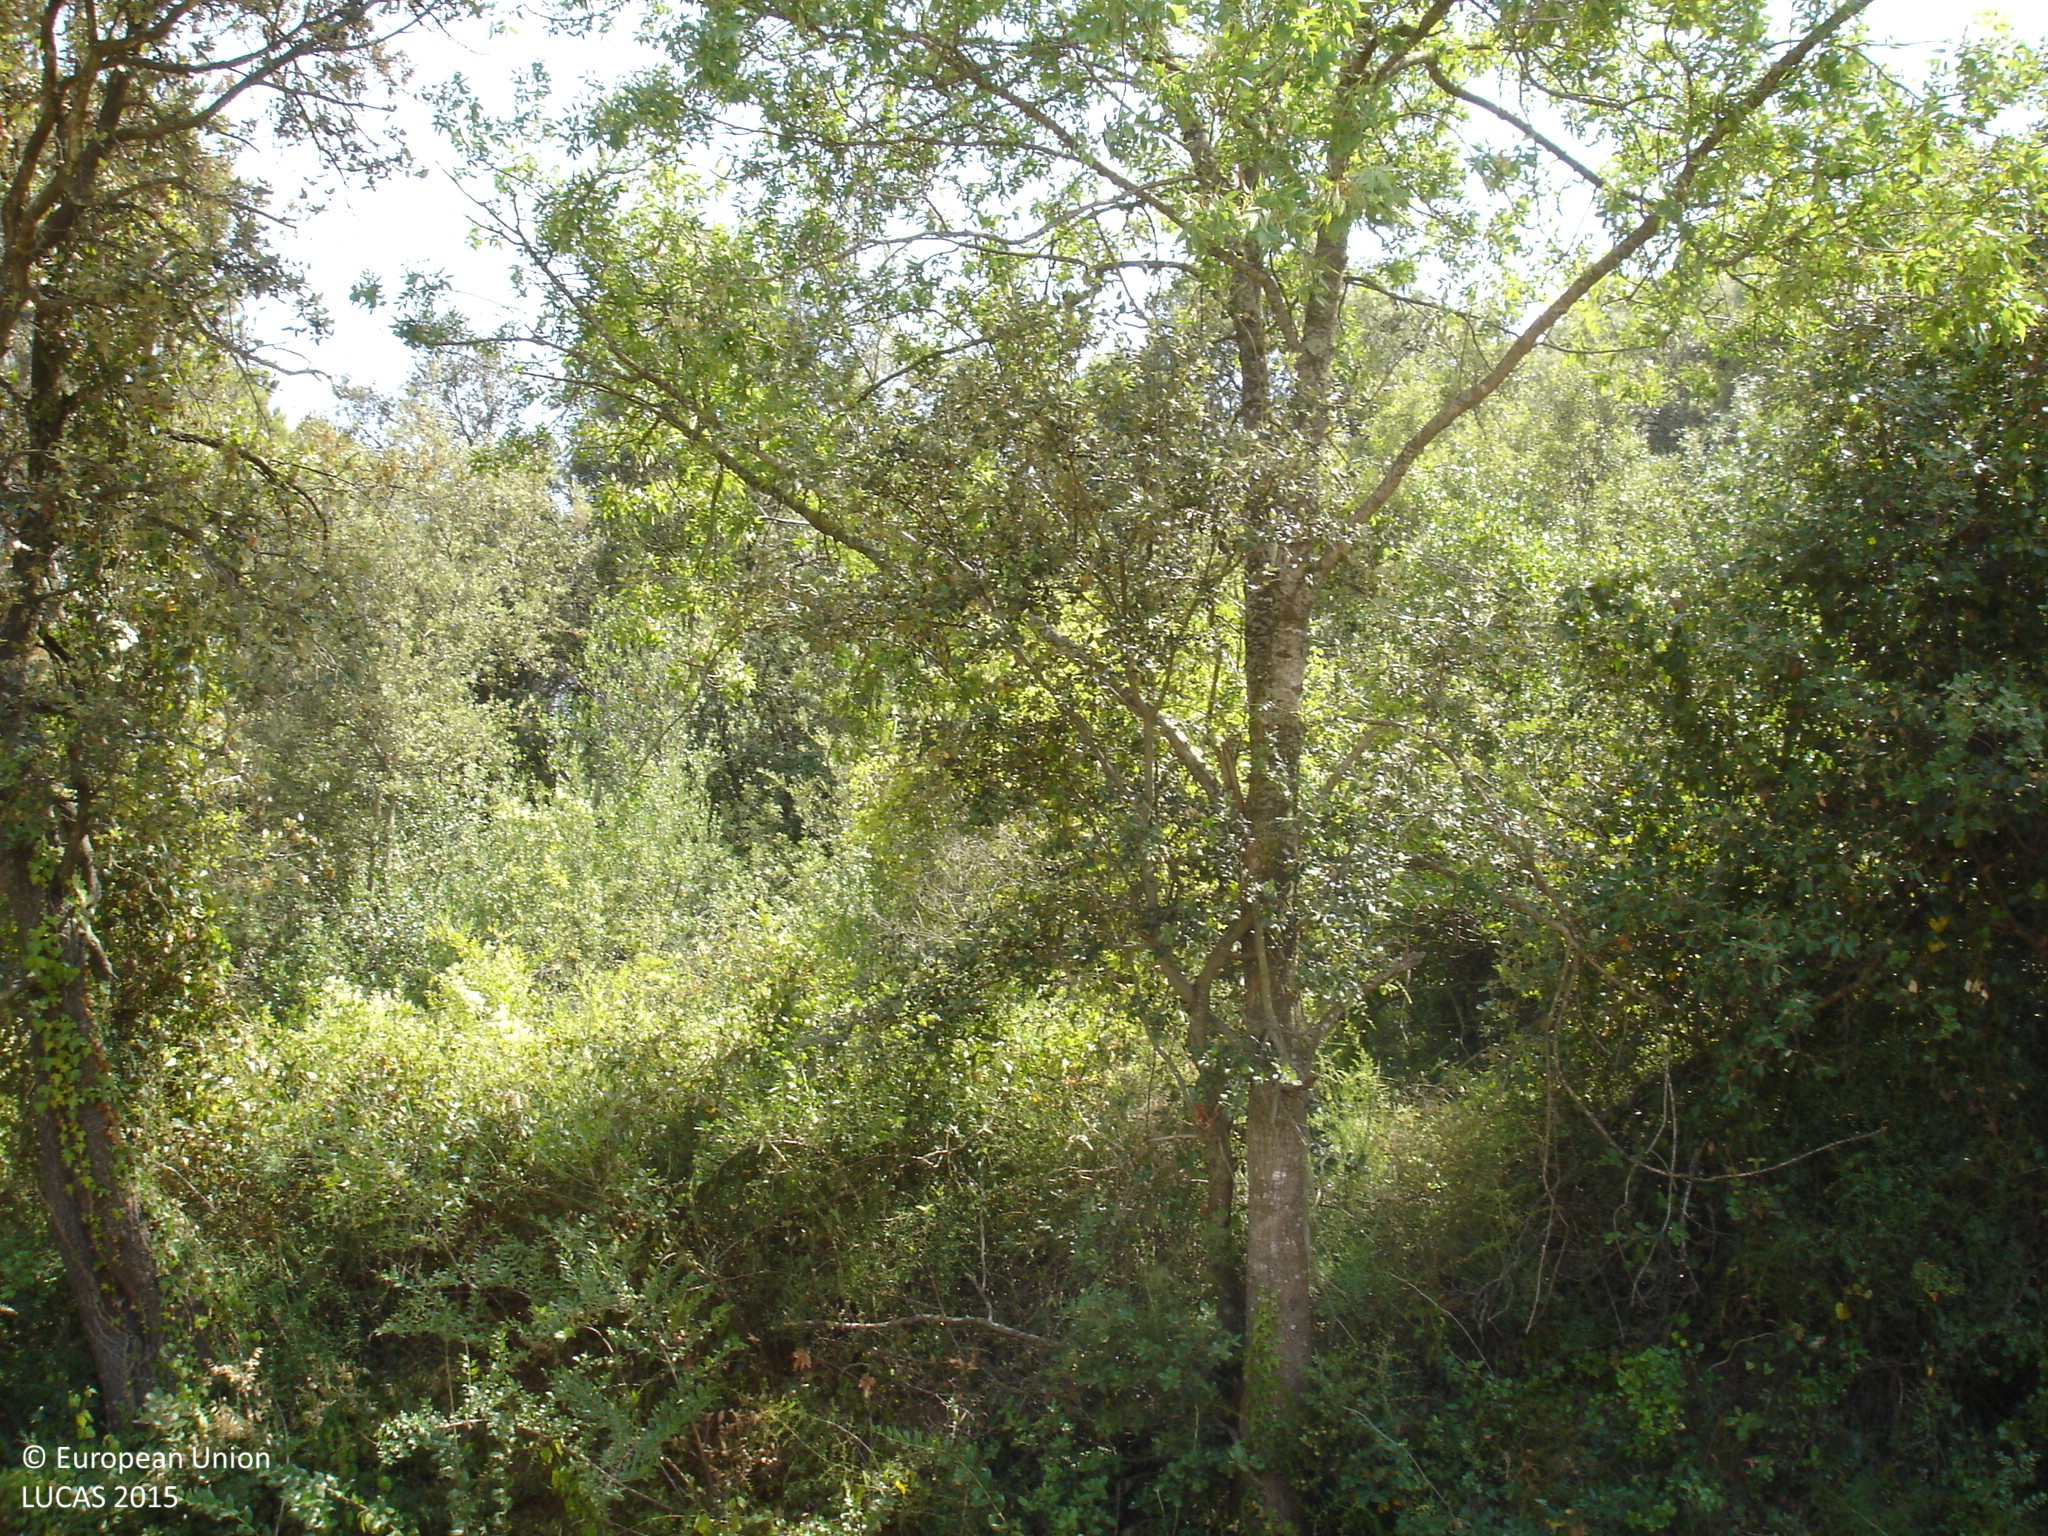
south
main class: Cropland
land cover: Lucerne
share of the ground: > 75 %
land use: Agriculture (excluding fallow land and kitchen gardens)
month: July
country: ES
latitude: 42.0309
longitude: 2.9978
